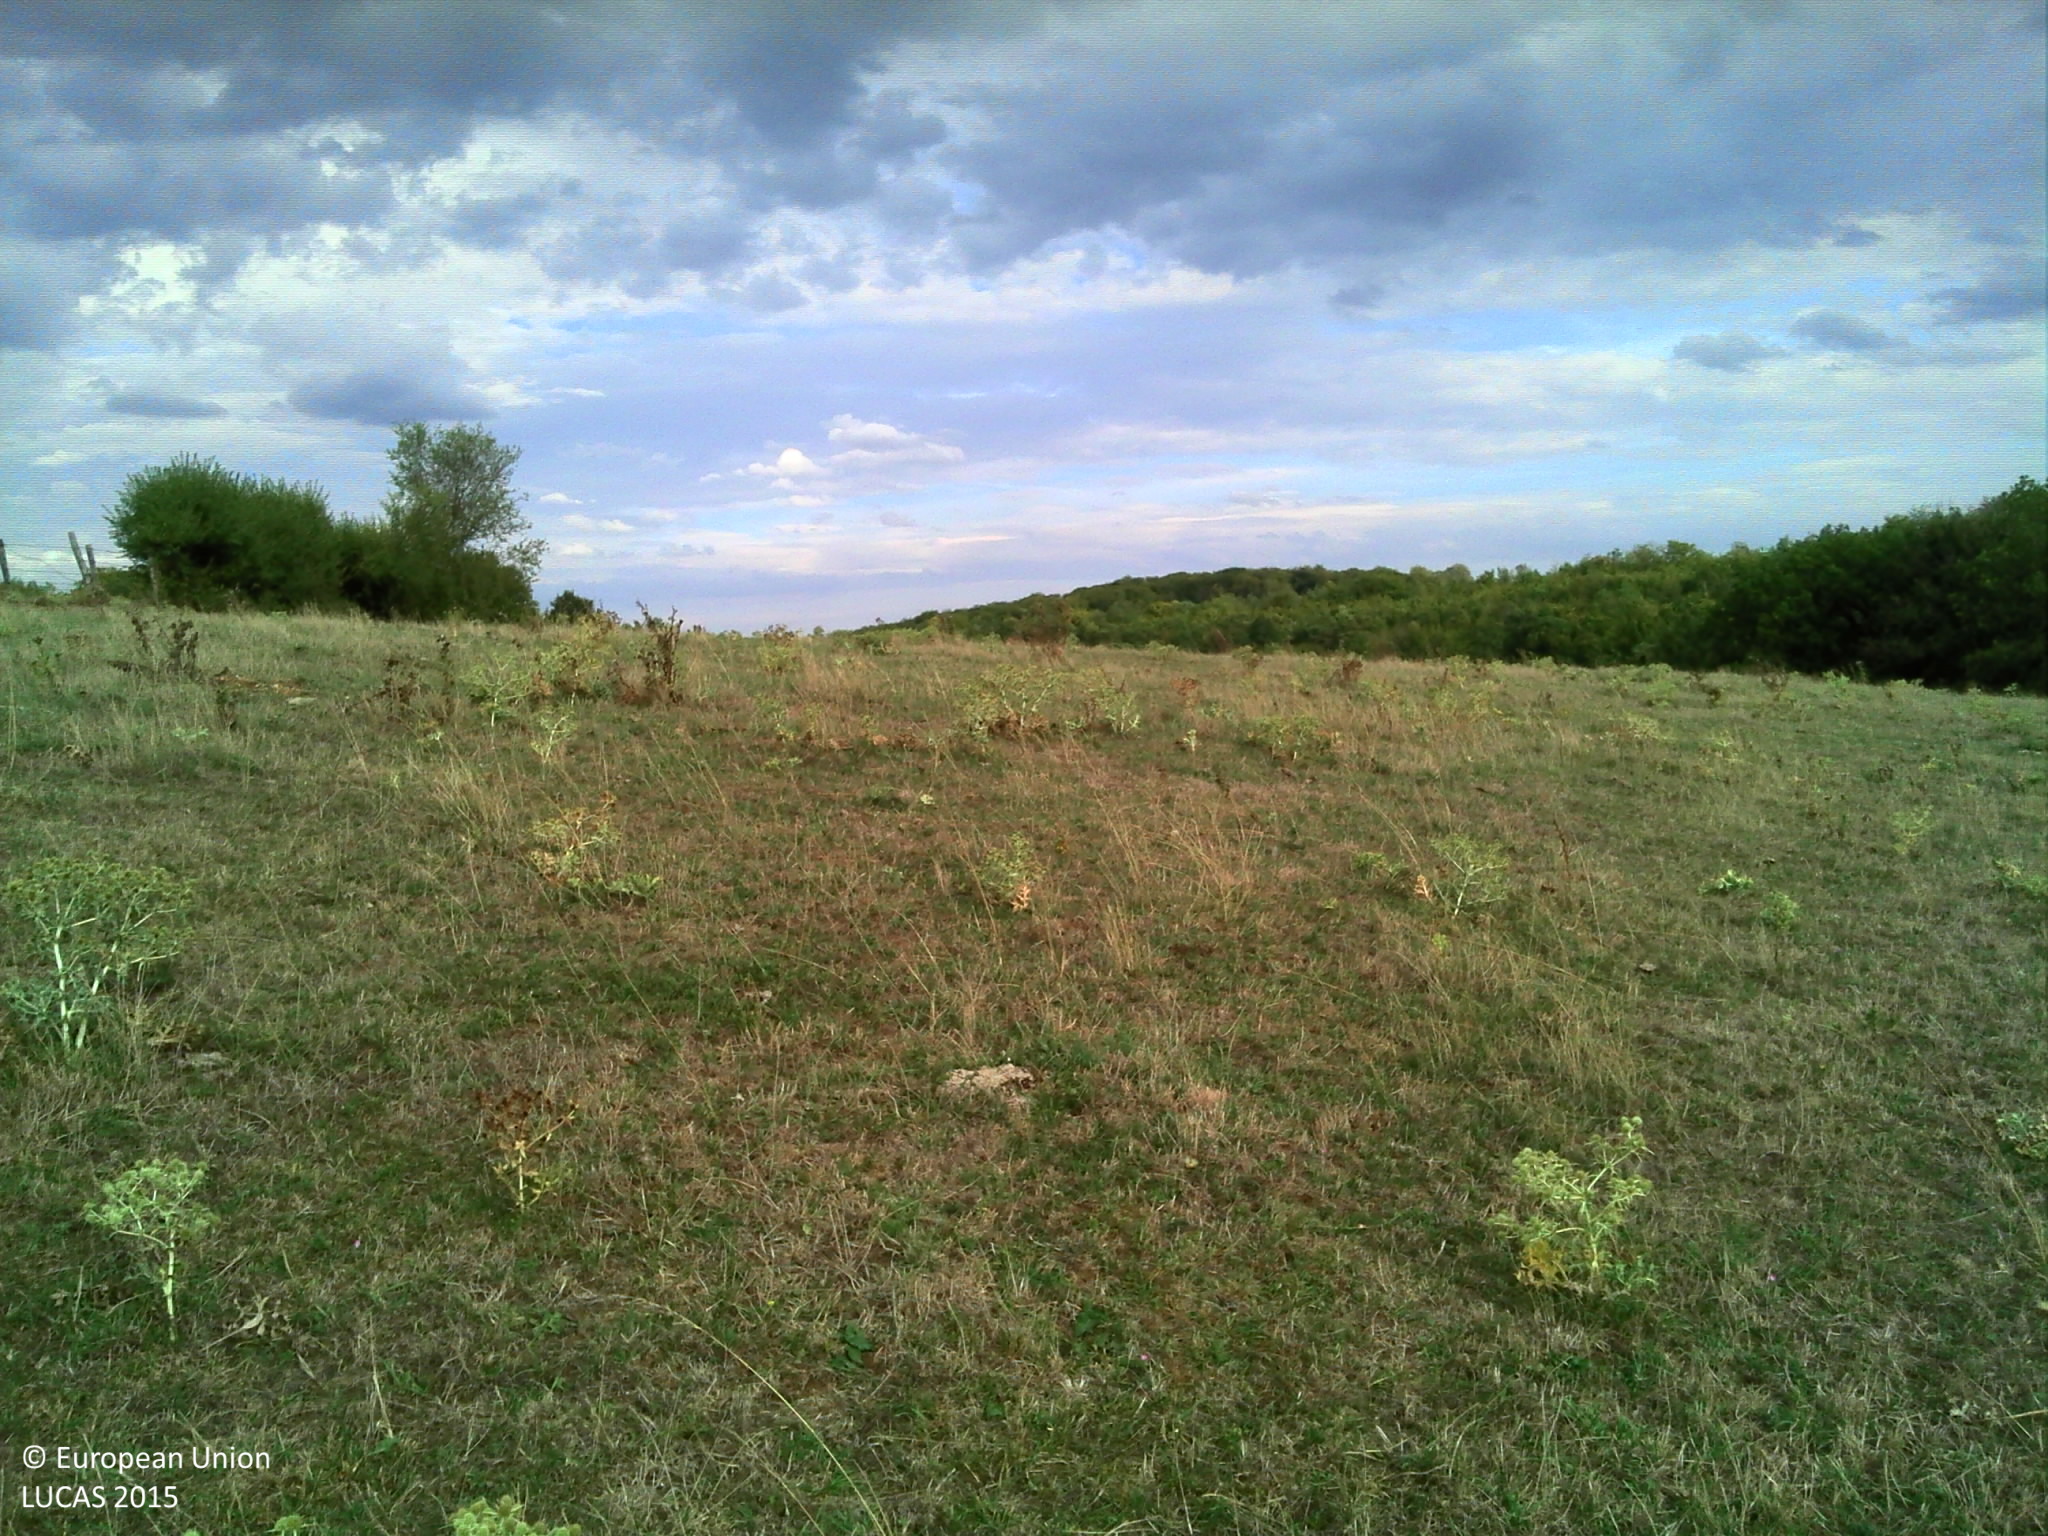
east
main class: Grassland
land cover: Grassland without tree/shrub cover
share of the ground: > 75 %
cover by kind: herbaceous plants 100 %
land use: Agriculture (excluding fallow land and kitchen gardens)
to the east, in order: Grassland without tree/shrub cover; Fences; Dry stone walls; Broadleaved woodland
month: August
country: FR
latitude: 47.7074
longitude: 4.8683
